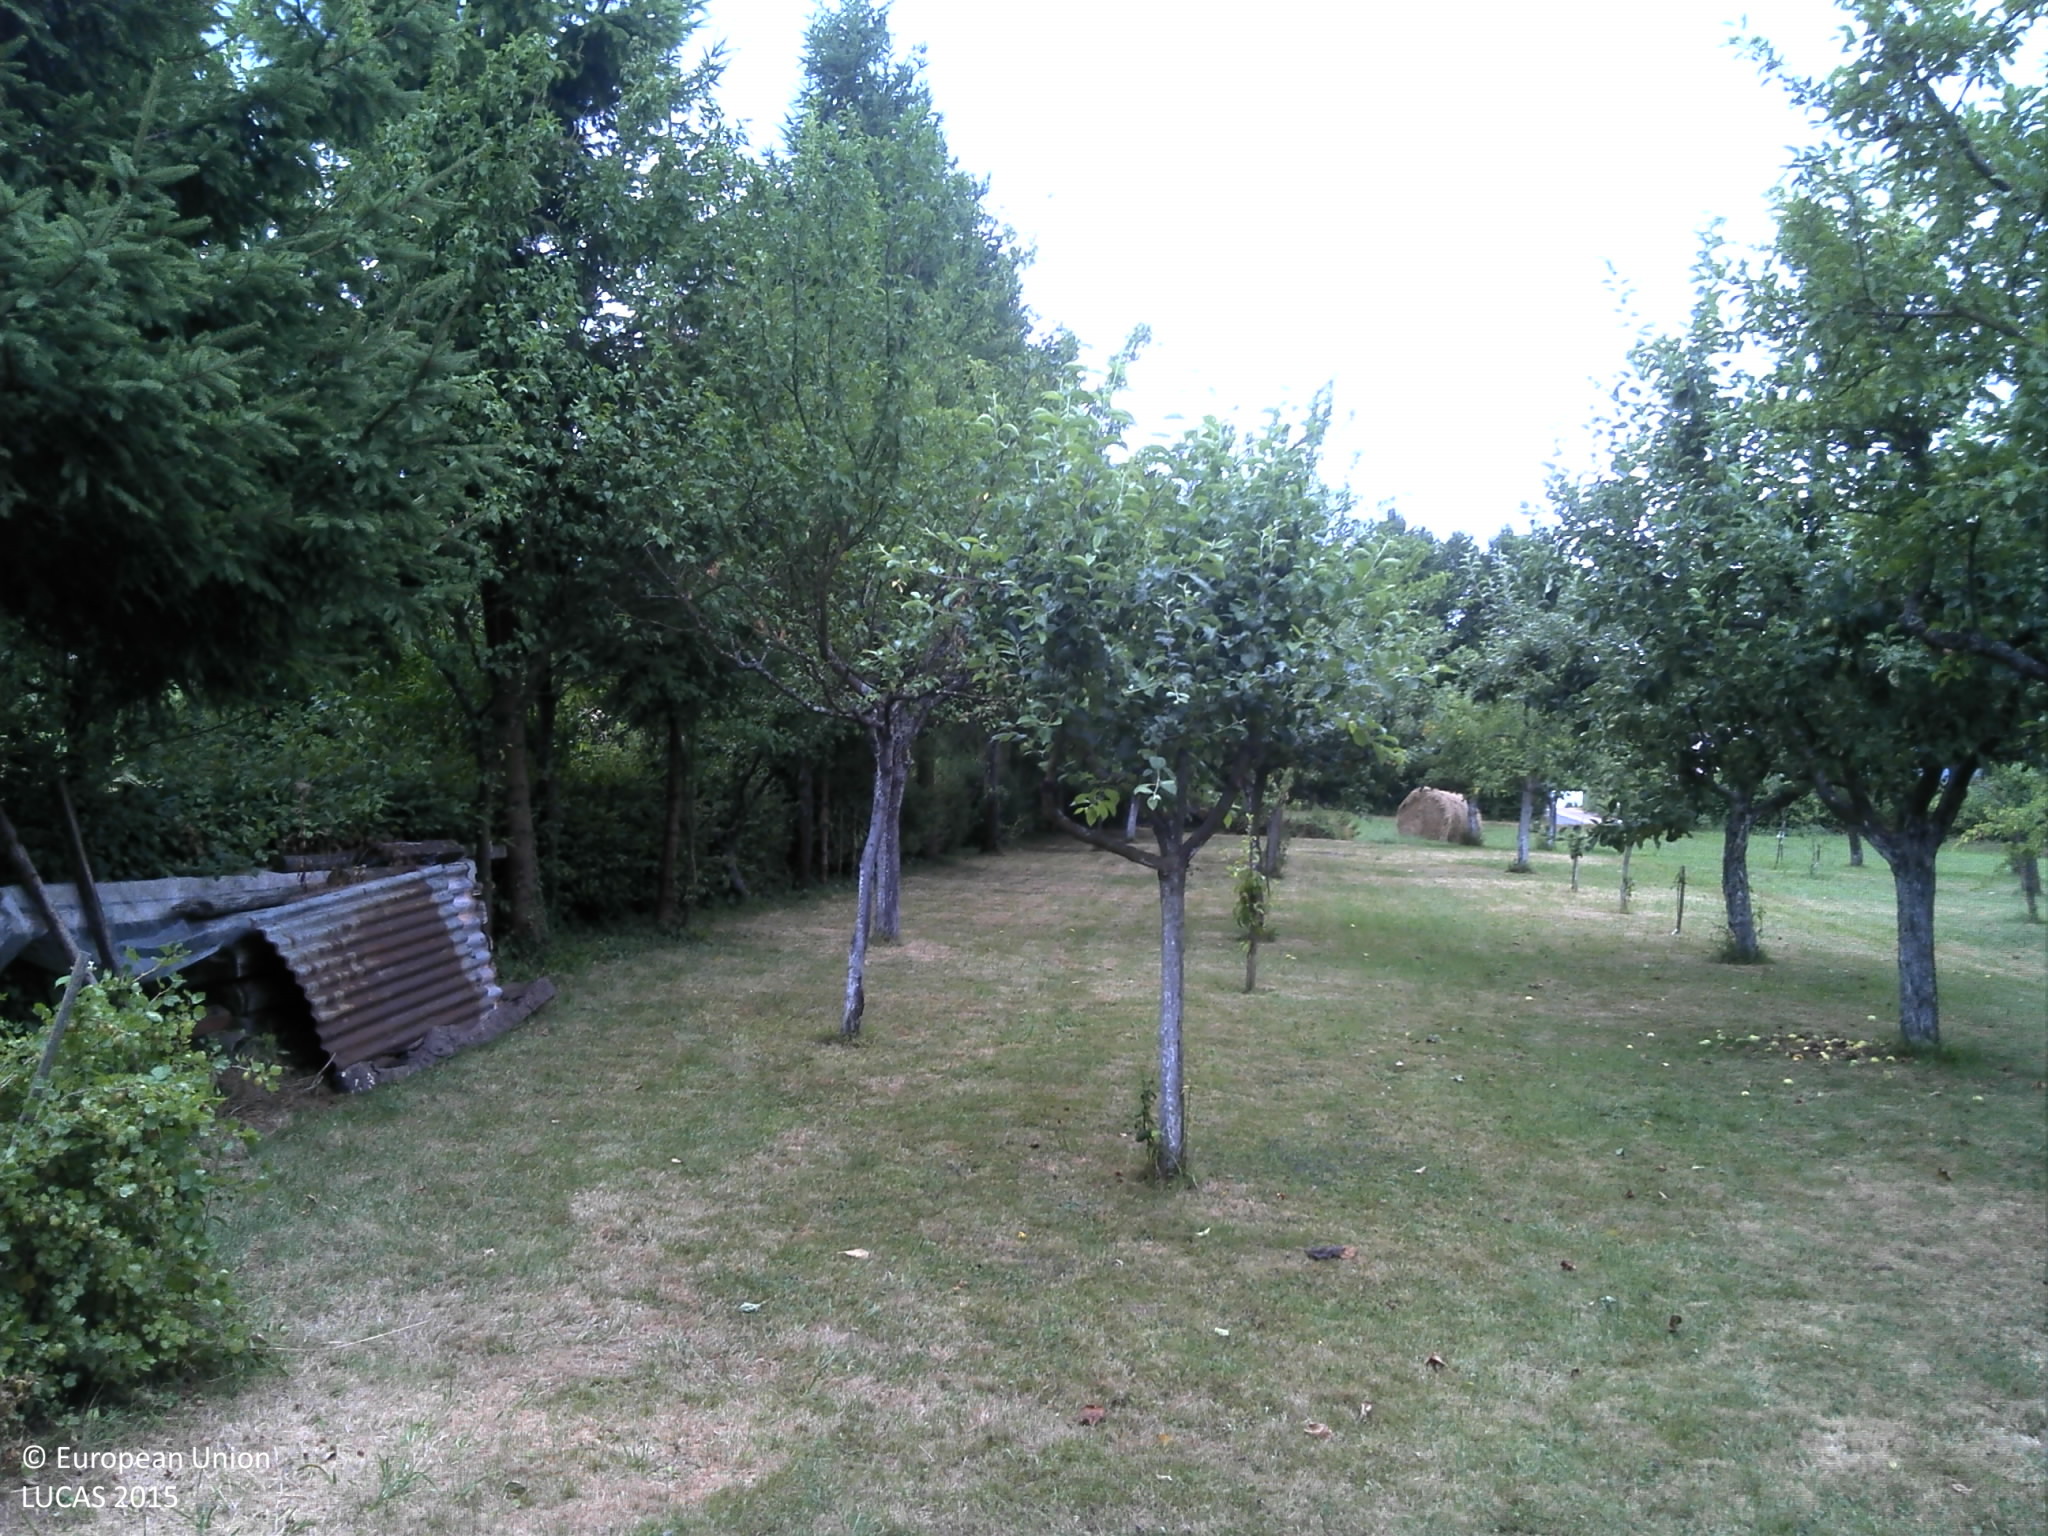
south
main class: Cropland
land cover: Apple fruit
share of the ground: > 75 %
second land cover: Grassland without tree/shrub cover
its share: > 75 %
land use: Kitchen garden
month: July
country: FR
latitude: 48.7664
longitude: 7.2932
